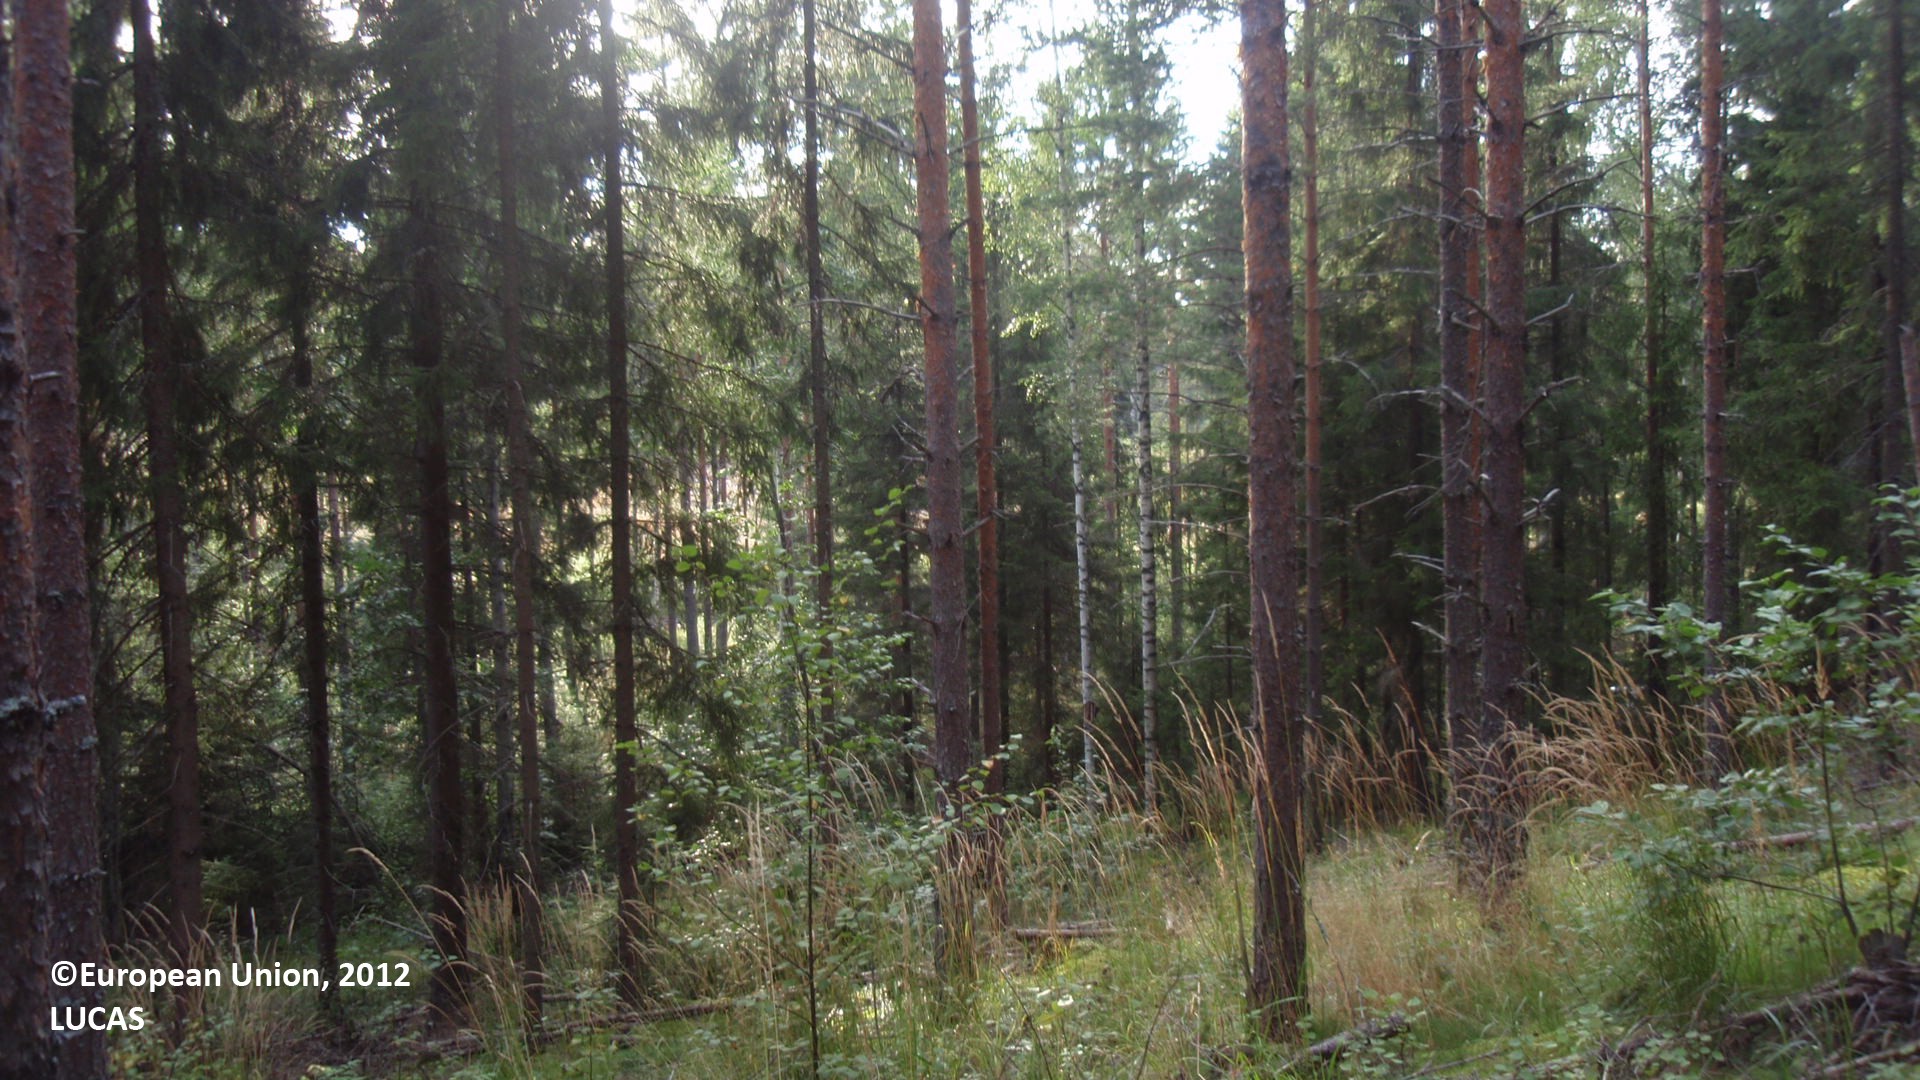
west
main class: Woodland
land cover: Pine dominated mixed woodland
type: boreal forest
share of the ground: 50 - 75 %
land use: Forestry
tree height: > 5 m
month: August
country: FI
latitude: 60.7248
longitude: 27.1684
